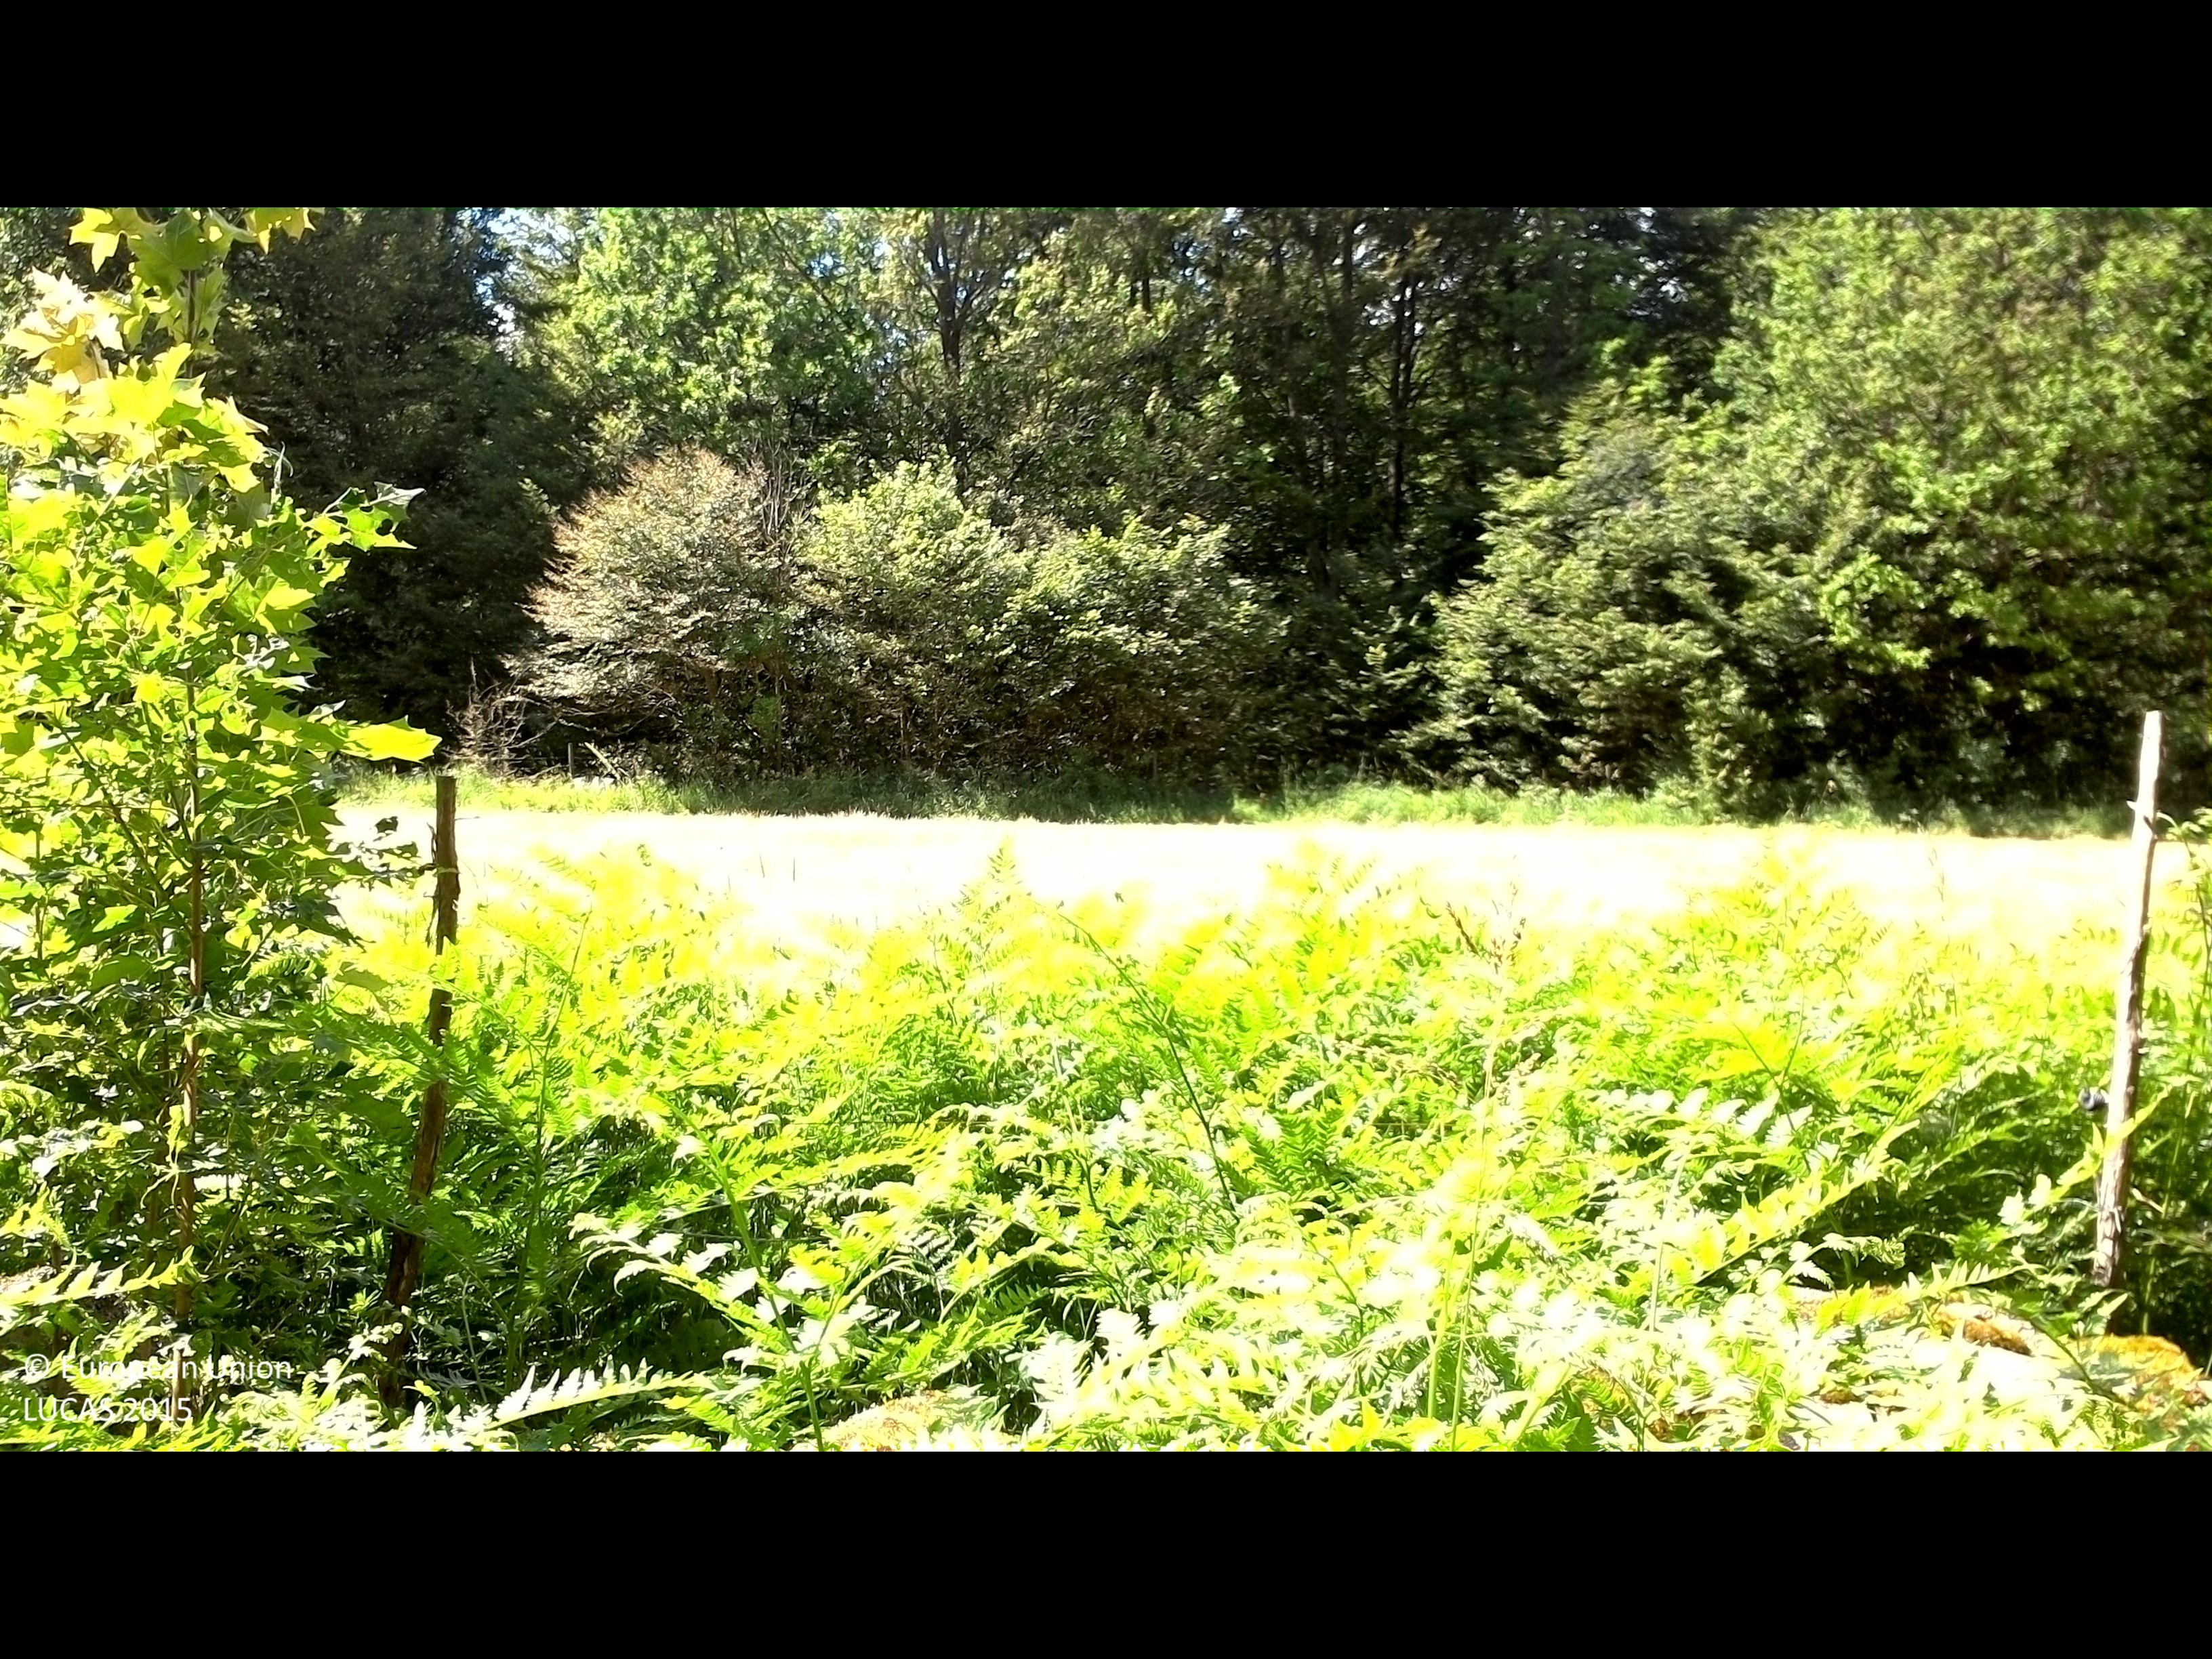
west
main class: Woodland
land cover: Broadleaved woodland
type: beech forest
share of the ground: > 75 %
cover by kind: broadleaved forest trees 75 %, herbaceous plants 20 %, shrubs 5 %
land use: Forestry
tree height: > 5 m
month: July
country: SE
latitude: 56.3709
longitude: 15.1958
